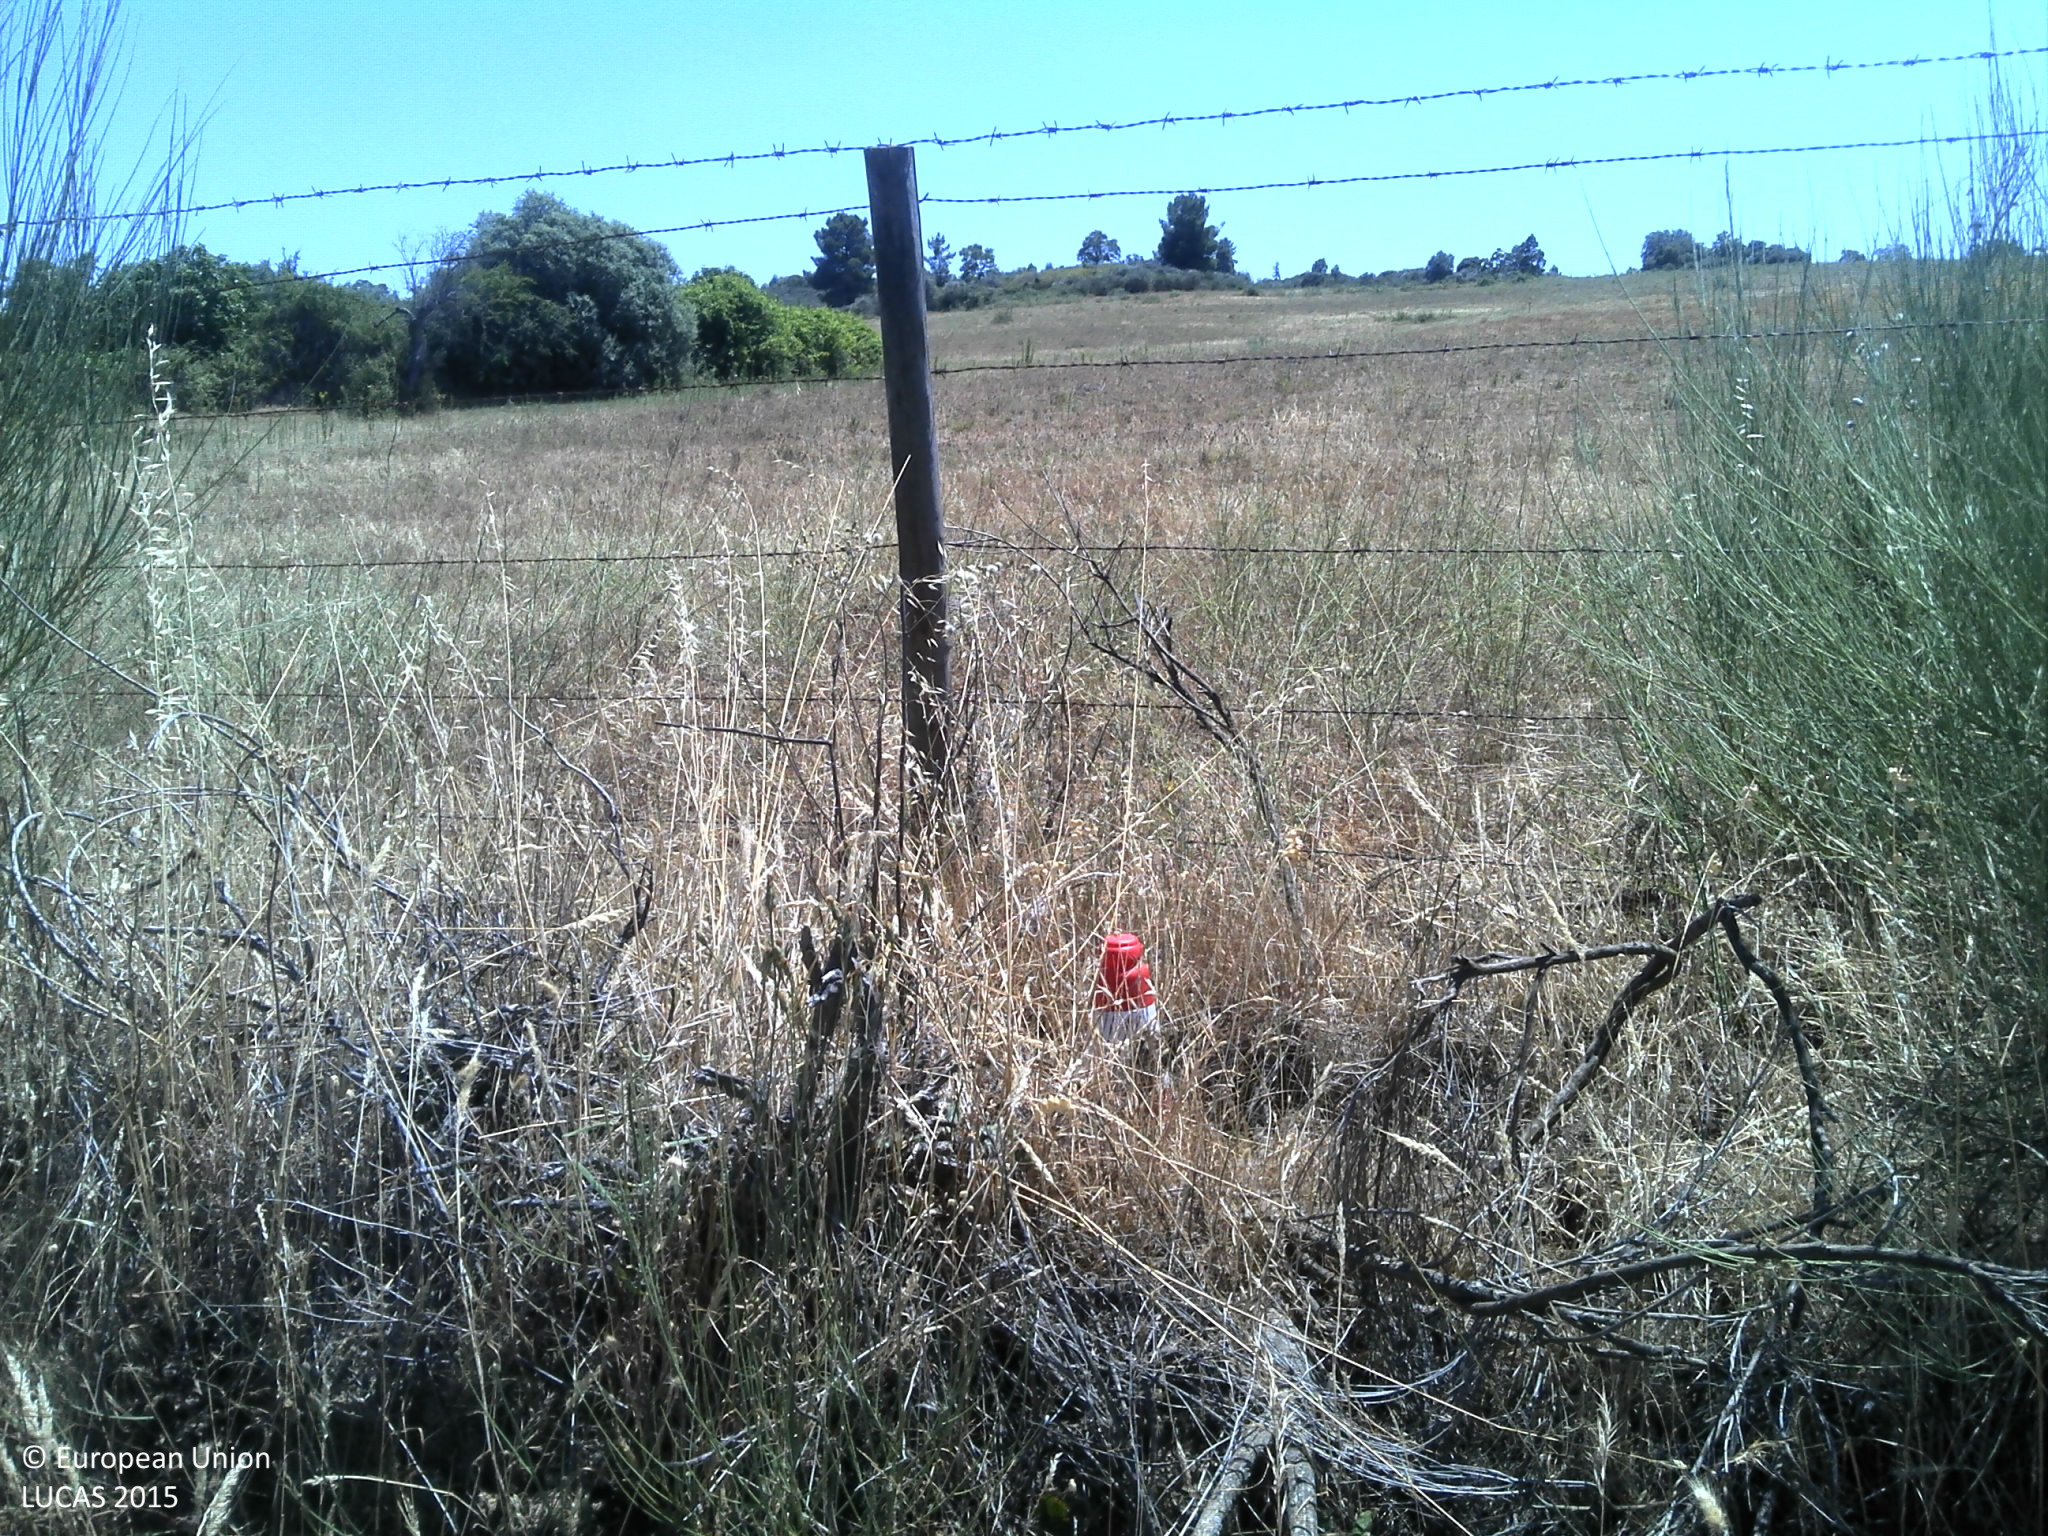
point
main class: Grassland
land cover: Grassland without tree/shrub cover
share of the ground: 50 - 75 %
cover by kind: herbaceous plants 65 %, unconsolidated bare surface 30 %
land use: Agriculture (excluding fallow land and kitchen gardens)
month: June
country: PT
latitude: 40.1119
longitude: -7.2391
